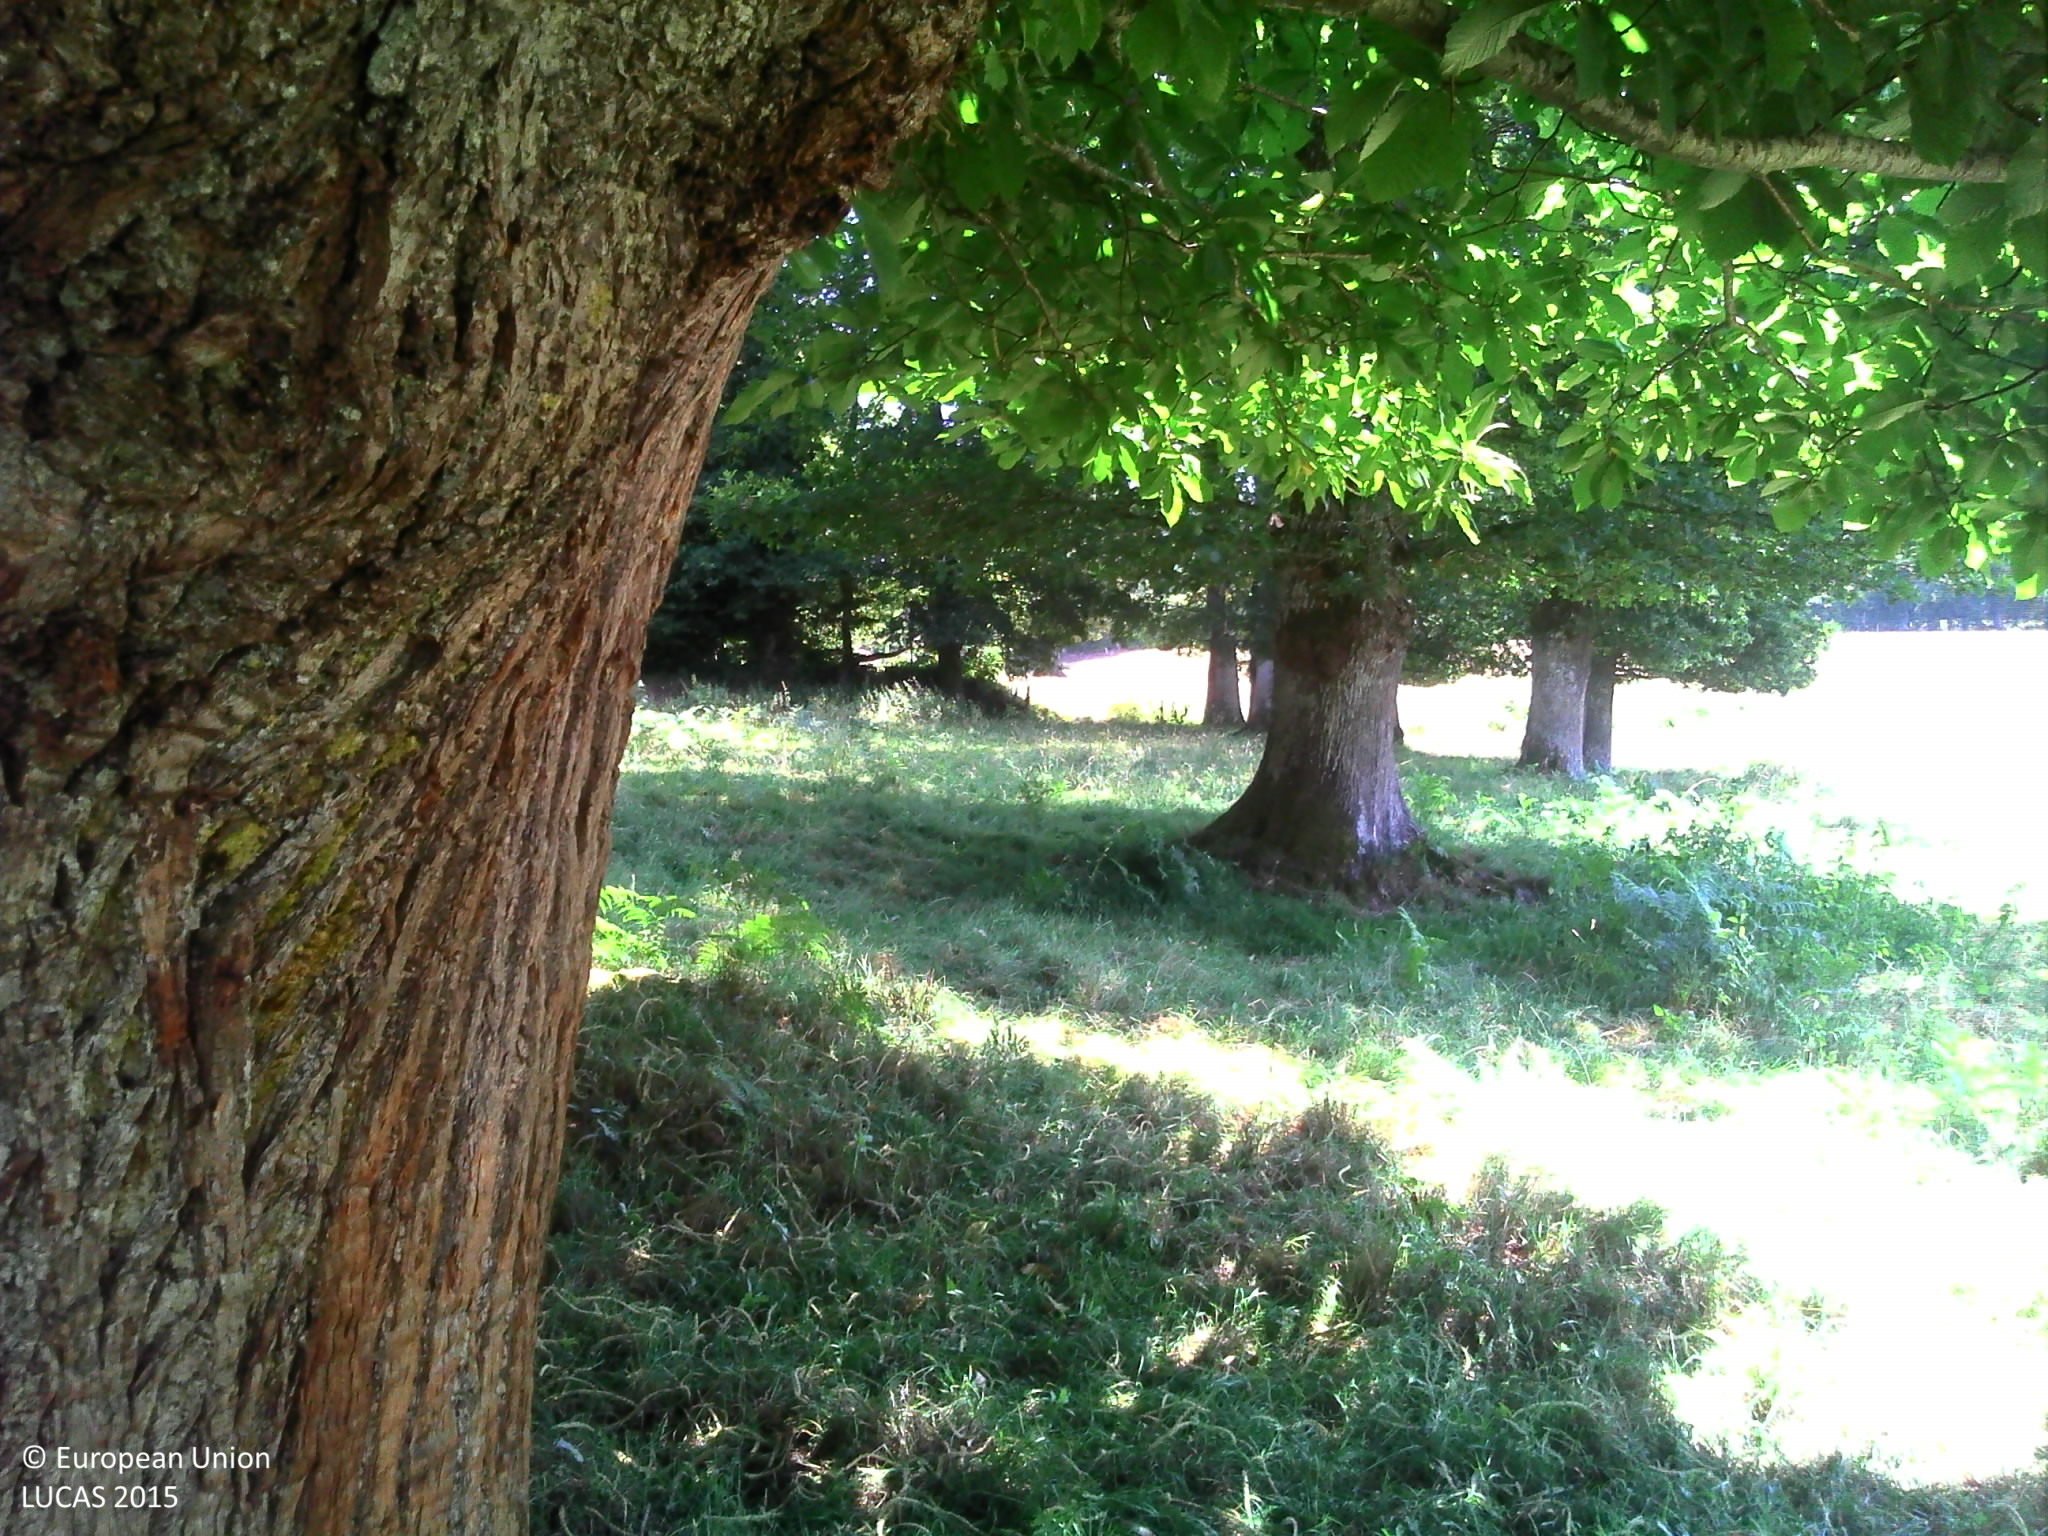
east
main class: Woodland
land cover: Broadleaved woodland
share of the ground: > 75 %
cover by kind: broadleaved forest trees 65 %, herbaceous plants 35 %
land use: Agriculture (excluding fallow land and kitchen gardens)
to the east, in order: Broadleaved woodland; Grassland without tree/shrub cover; Broadleaved woodland; Fences; Grassland without tree/shrub cover; Broadleaved woodland; Grassland without tree/shrub cover; Rivers and streams; Managed hedges; Fences; Grass margins; Tracks; Grass margins; Broadleaved woodland; Grassland without tree/shrub cover; Broadleaved woodland; Grassland without tree/shrub cover
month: July
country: FR
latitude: 46.2039
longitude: 1.6323
